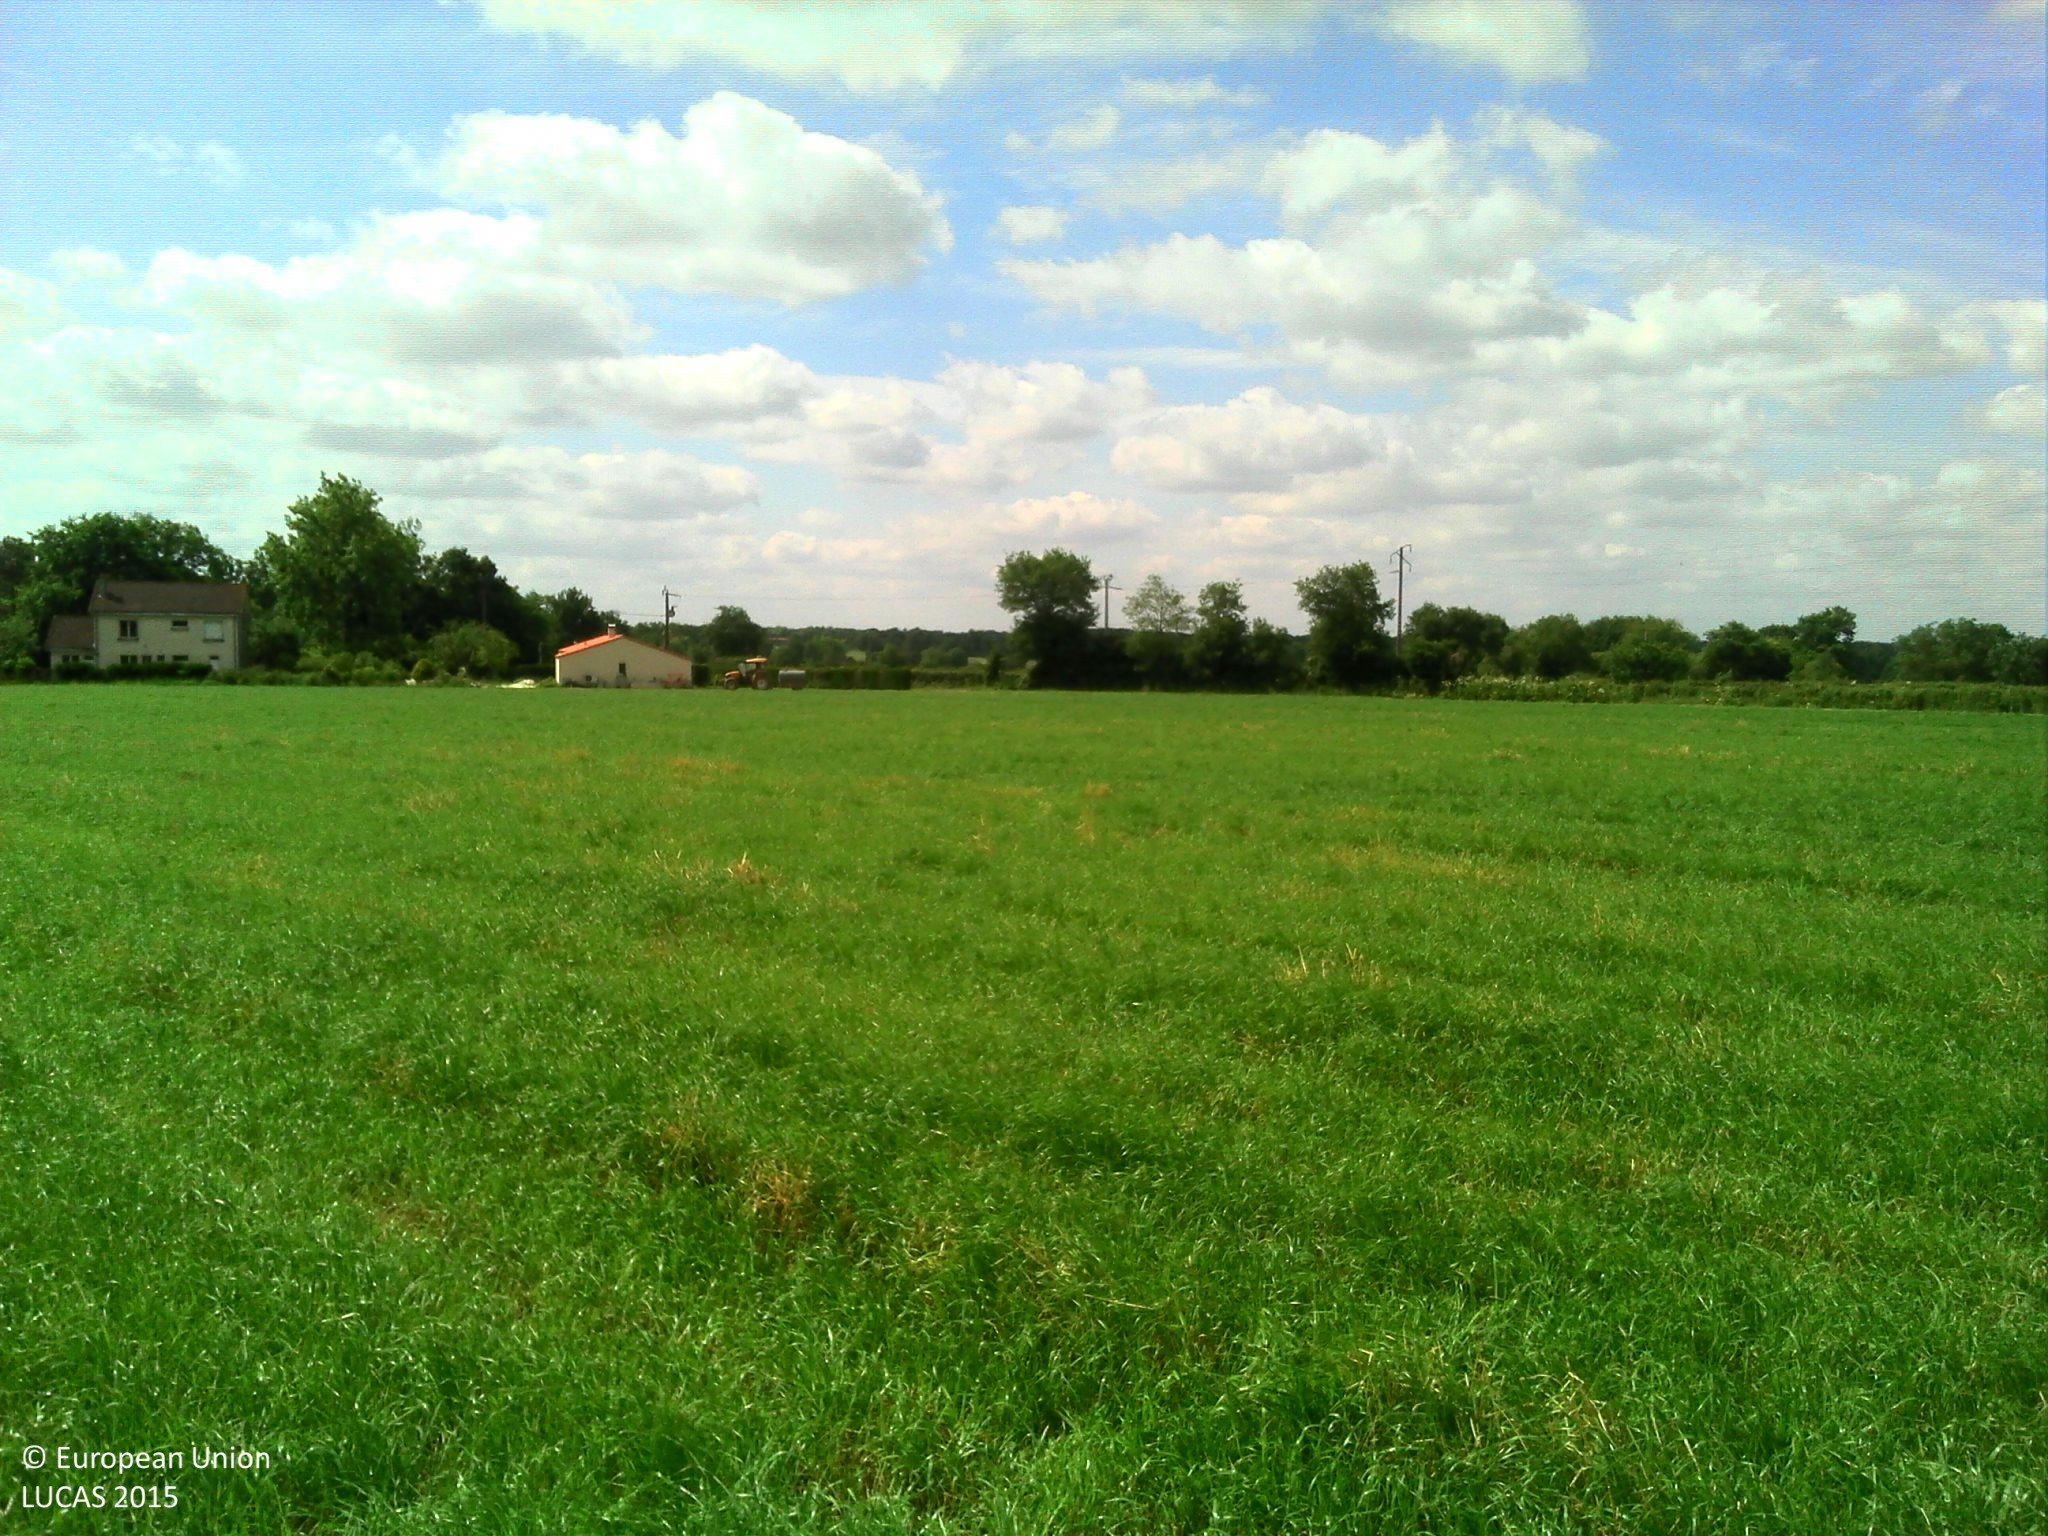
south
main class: Grassland
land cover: Grassland without tree/shrub cover
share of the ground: > 75 %
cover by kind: herbaceous plants 100 %
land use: Agriculture (excluding fallow land and kitchen gardens)
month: May
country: FR
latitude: 47.0473
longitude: -1.2388
